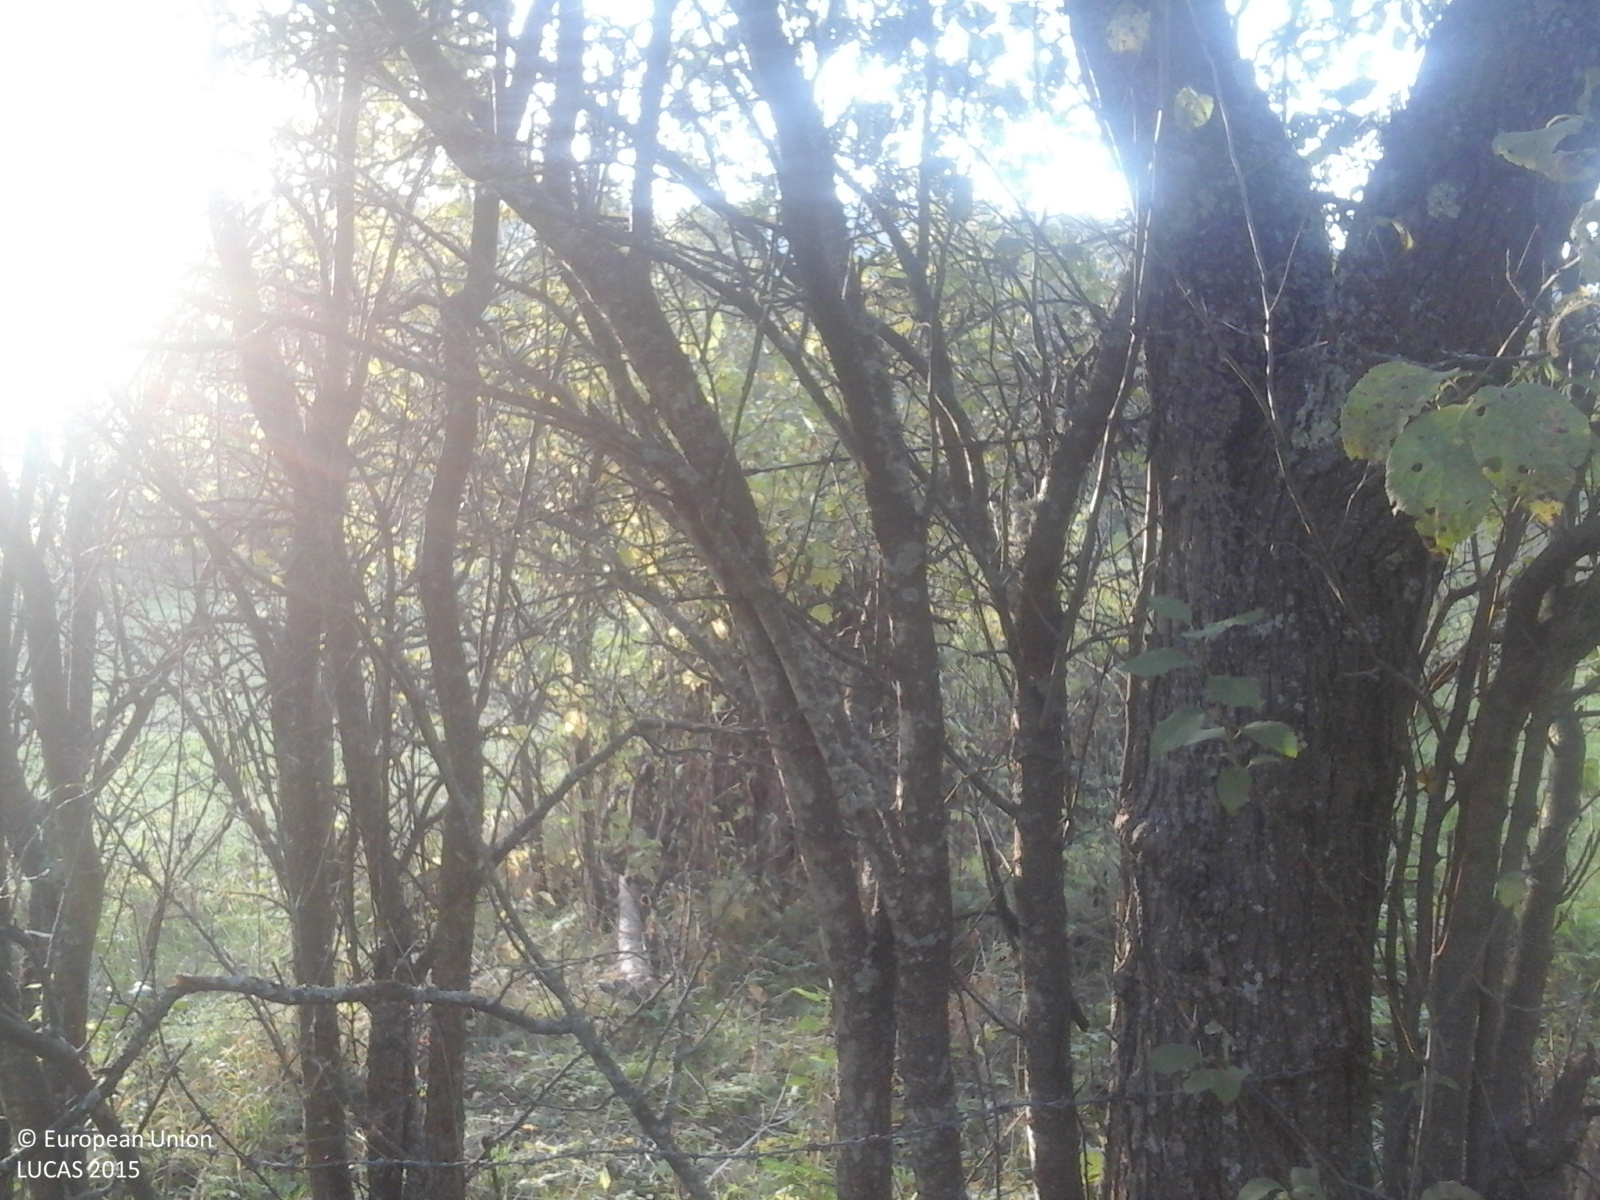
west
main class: Woodland
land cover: Broadleaved woodland
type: acidophilous oak and oak-birch forest
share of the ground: > 75 %
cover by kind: broadleaved forest trees 100 %
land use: Forestry
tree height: > 5 m
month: October
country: RO
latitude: 46.2714
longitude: 25.4036
